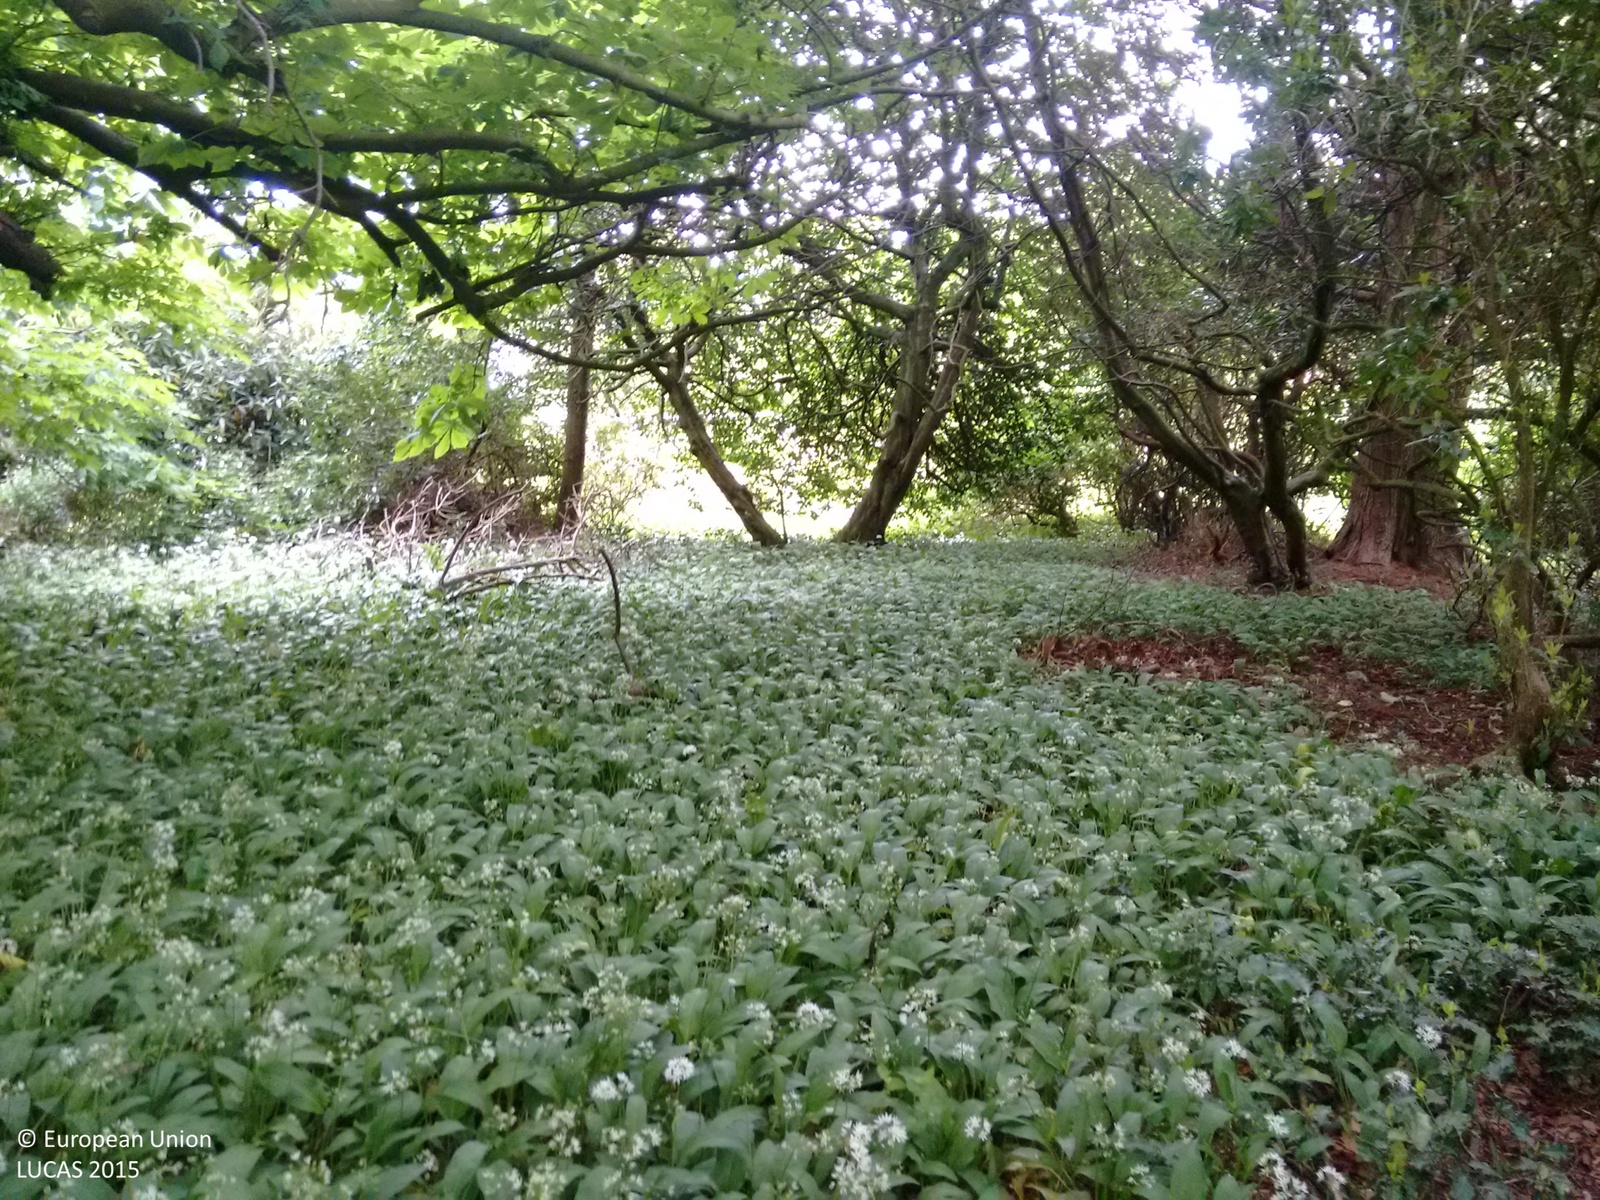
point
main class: Woodland
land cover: Other mixed woodland
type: exotic forest
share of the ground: > 75 %
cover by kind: broadleaved forest trees 75 %, coniferous forest trees 25 %
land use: Semi-natural and natural areas not in use
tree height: > 5 m
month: June
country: GB
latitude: 55.5506
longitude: -1.7955
